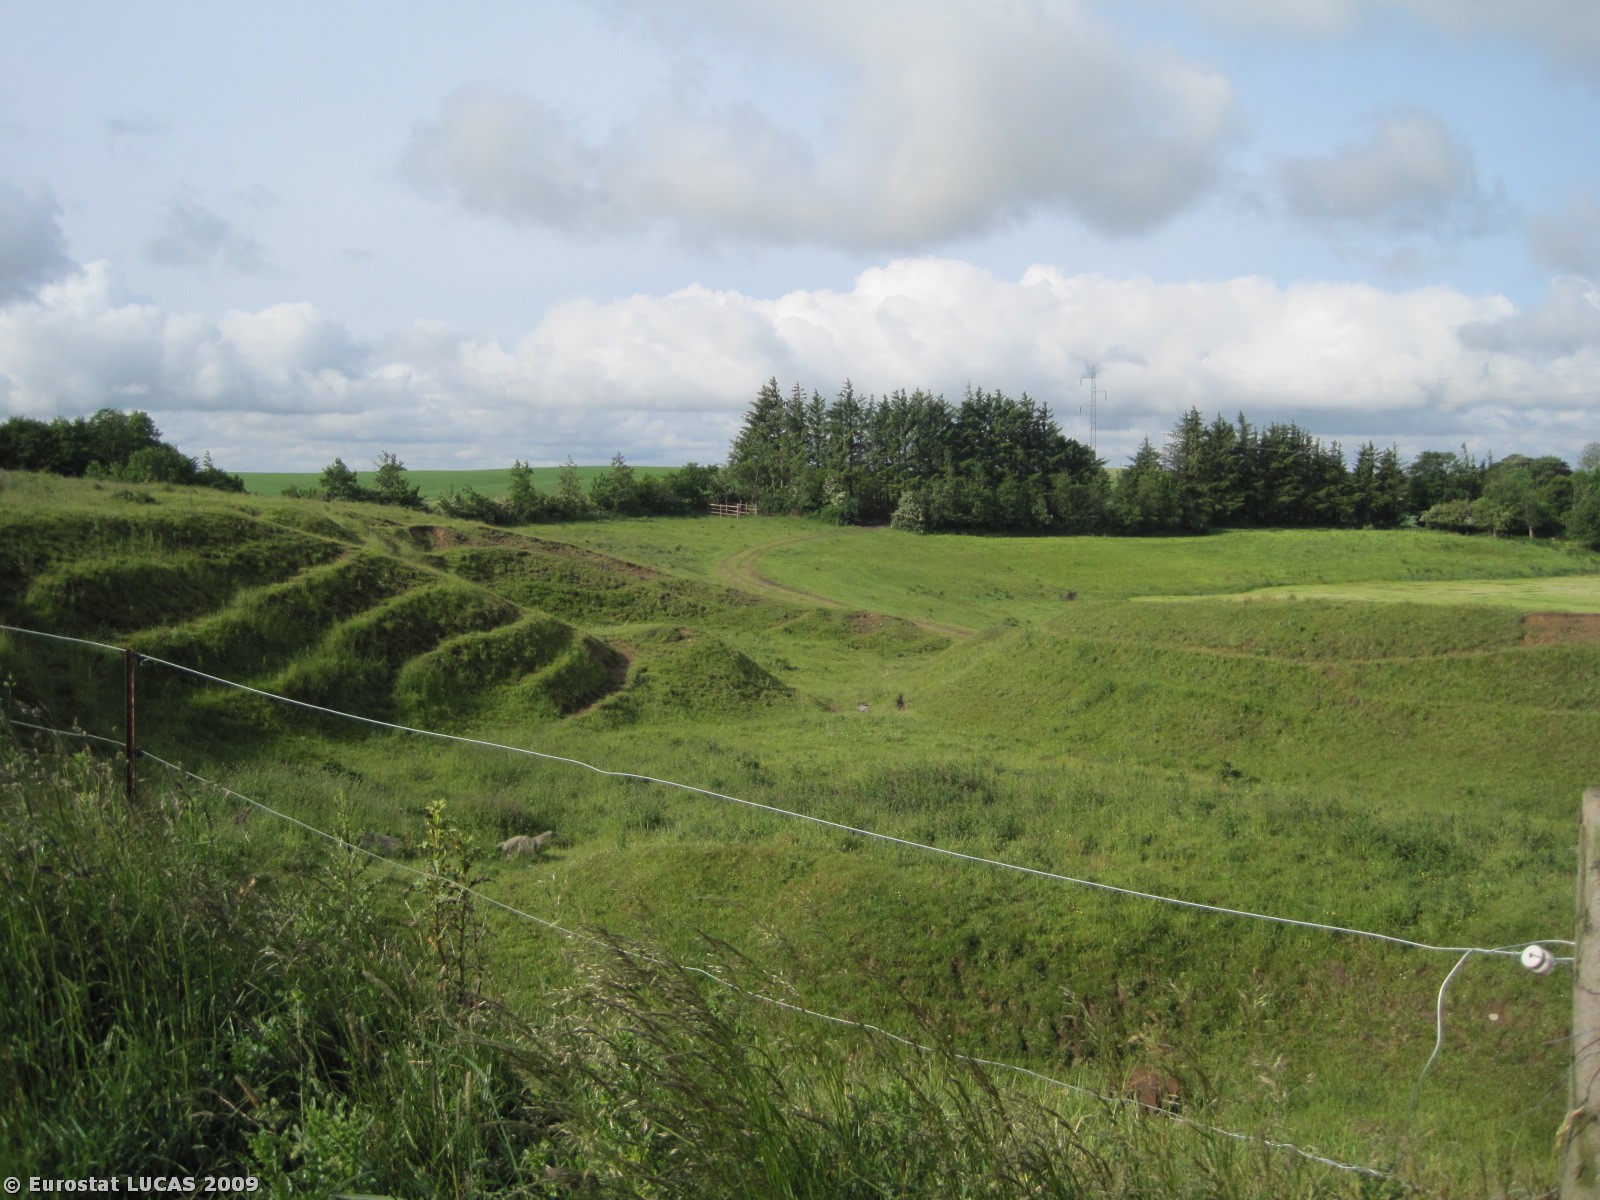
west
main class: Grassland
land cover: Grassland without tree/shrub cover
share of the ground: > 75 %
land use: Agriculture (excluding fallow land and kitchen gardens)
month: June
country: DK
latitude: 57.3023
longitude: 10.1491
